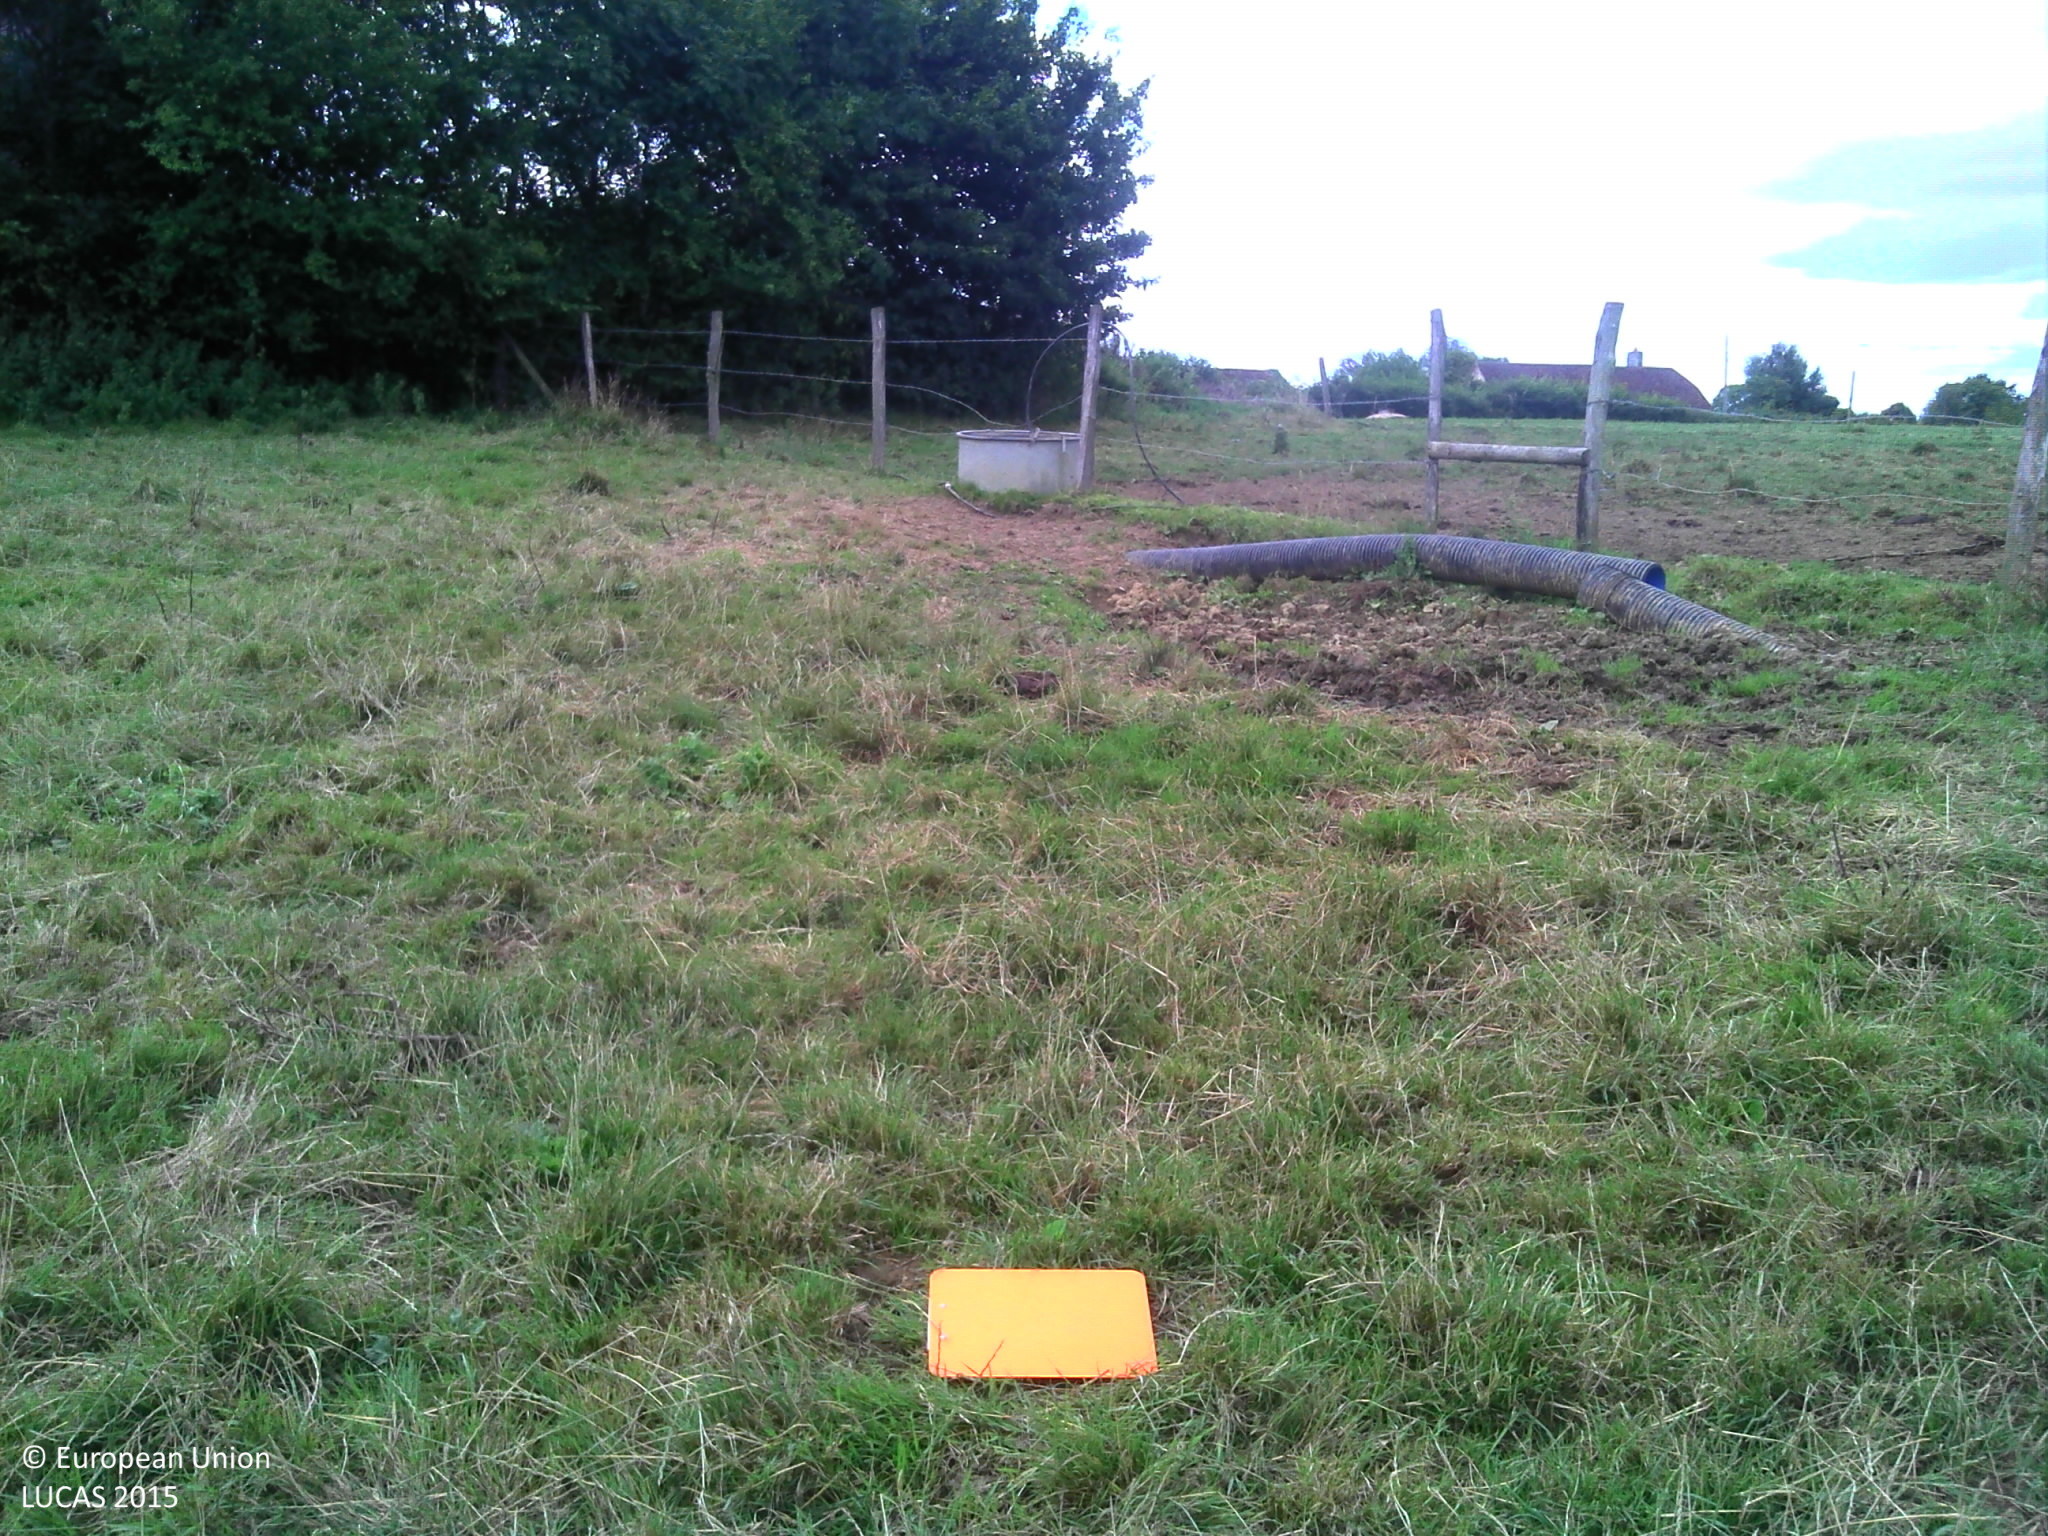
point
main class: Grassland
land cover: Grassland without tree/shrub cover
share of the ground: > 75 %
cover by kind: herbaceous plants 100 %
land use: Agriculture (excluding fallow land and kitchen gardens)
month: July
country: FR
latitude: 48.9143
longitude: 0.0498
